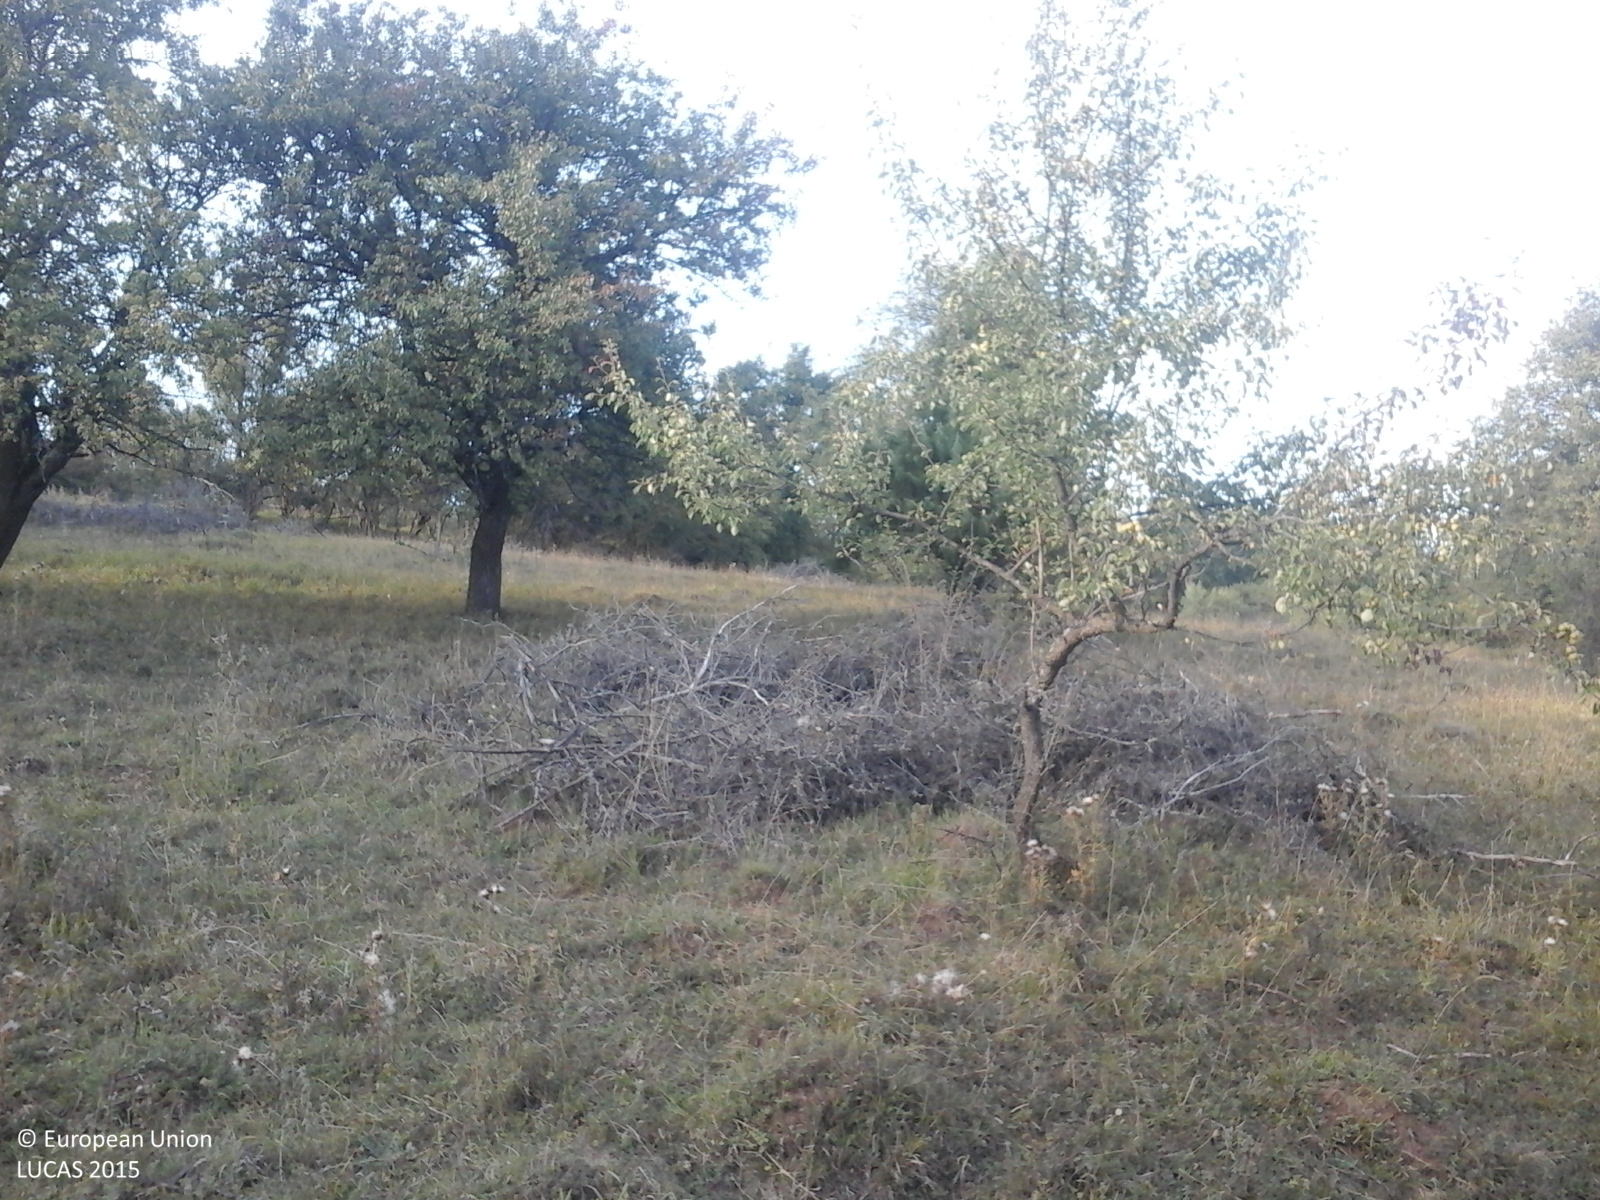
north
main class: Grassland
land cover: Grassland with sparse tree/shrub cover
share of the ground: > 75 %
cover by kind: herbaceous plants 85 %, shrubs 10 %, broadleaved forest trees 5 %
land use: Fallow land
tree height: < 5 m
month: September
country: RO
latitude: 46.8206
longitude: 23.0781
